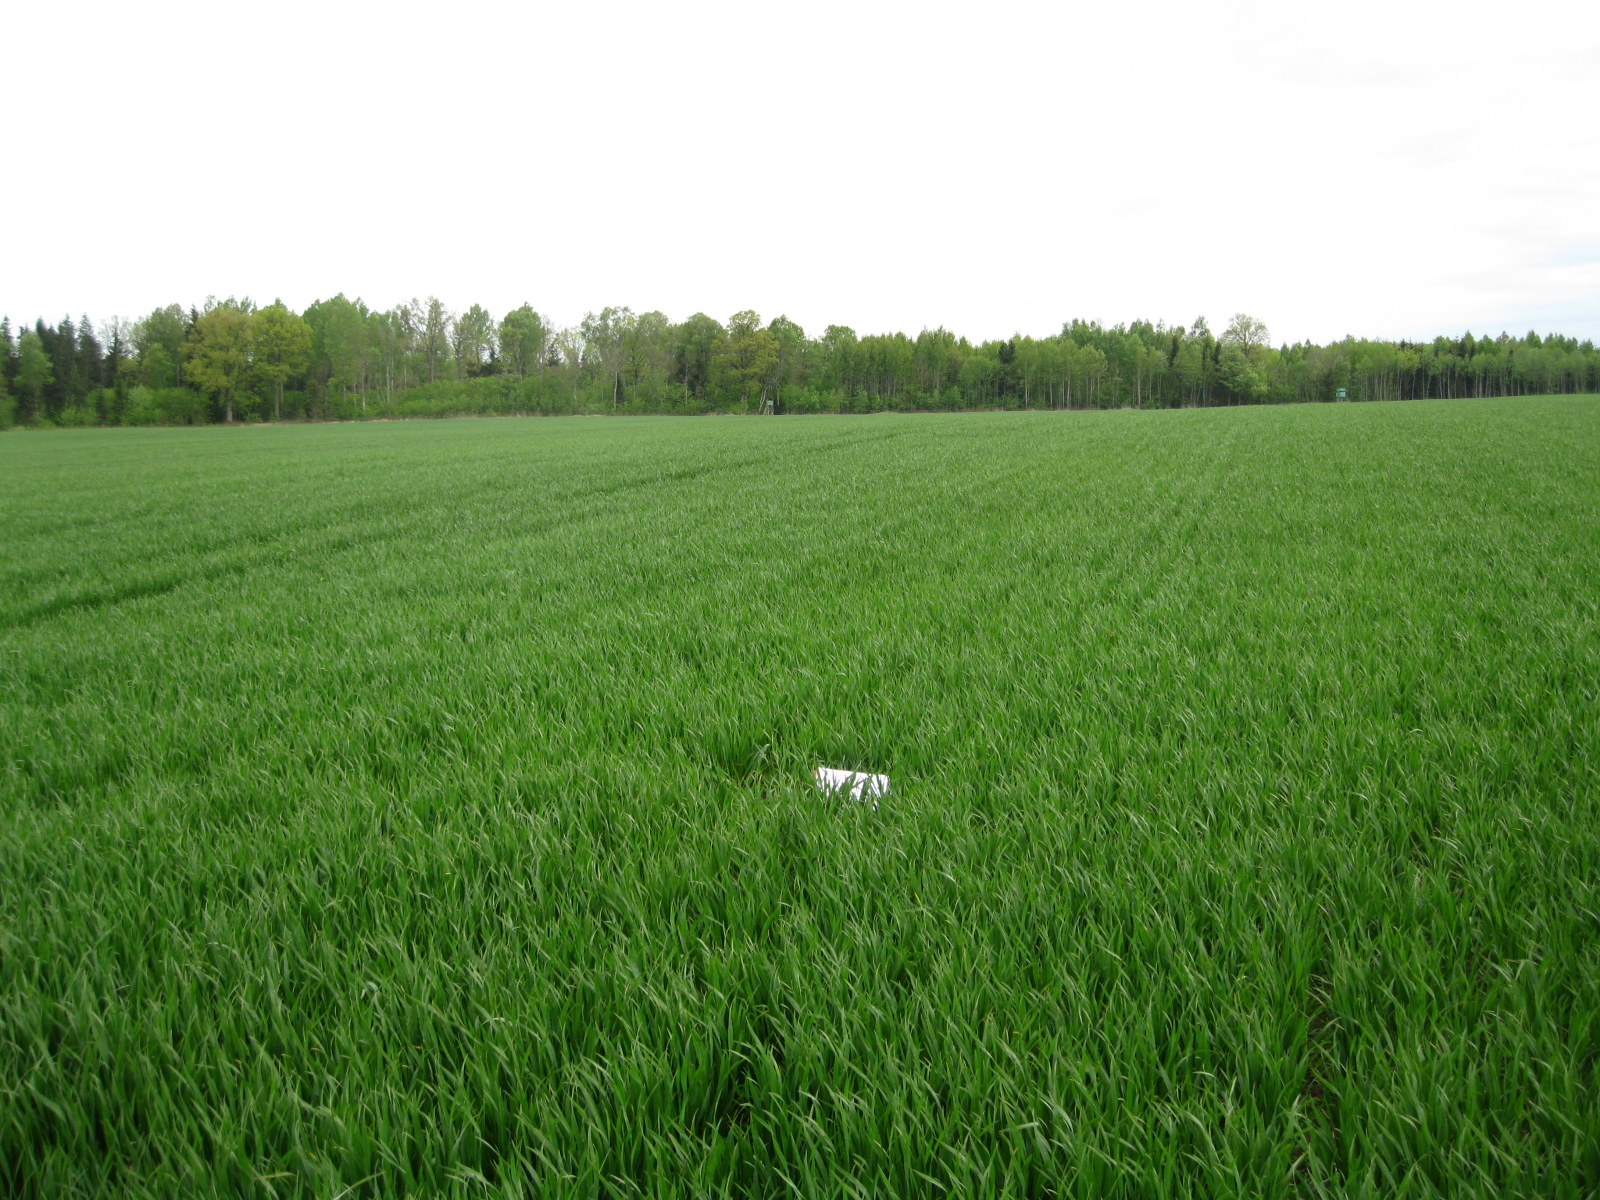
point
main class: Cropland
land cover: Barley
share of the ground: > 75 %
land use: Agriculture (excluding fallow land and kitchen gardens)
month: May
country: LT
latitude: 56.2101
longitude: 23.4078
